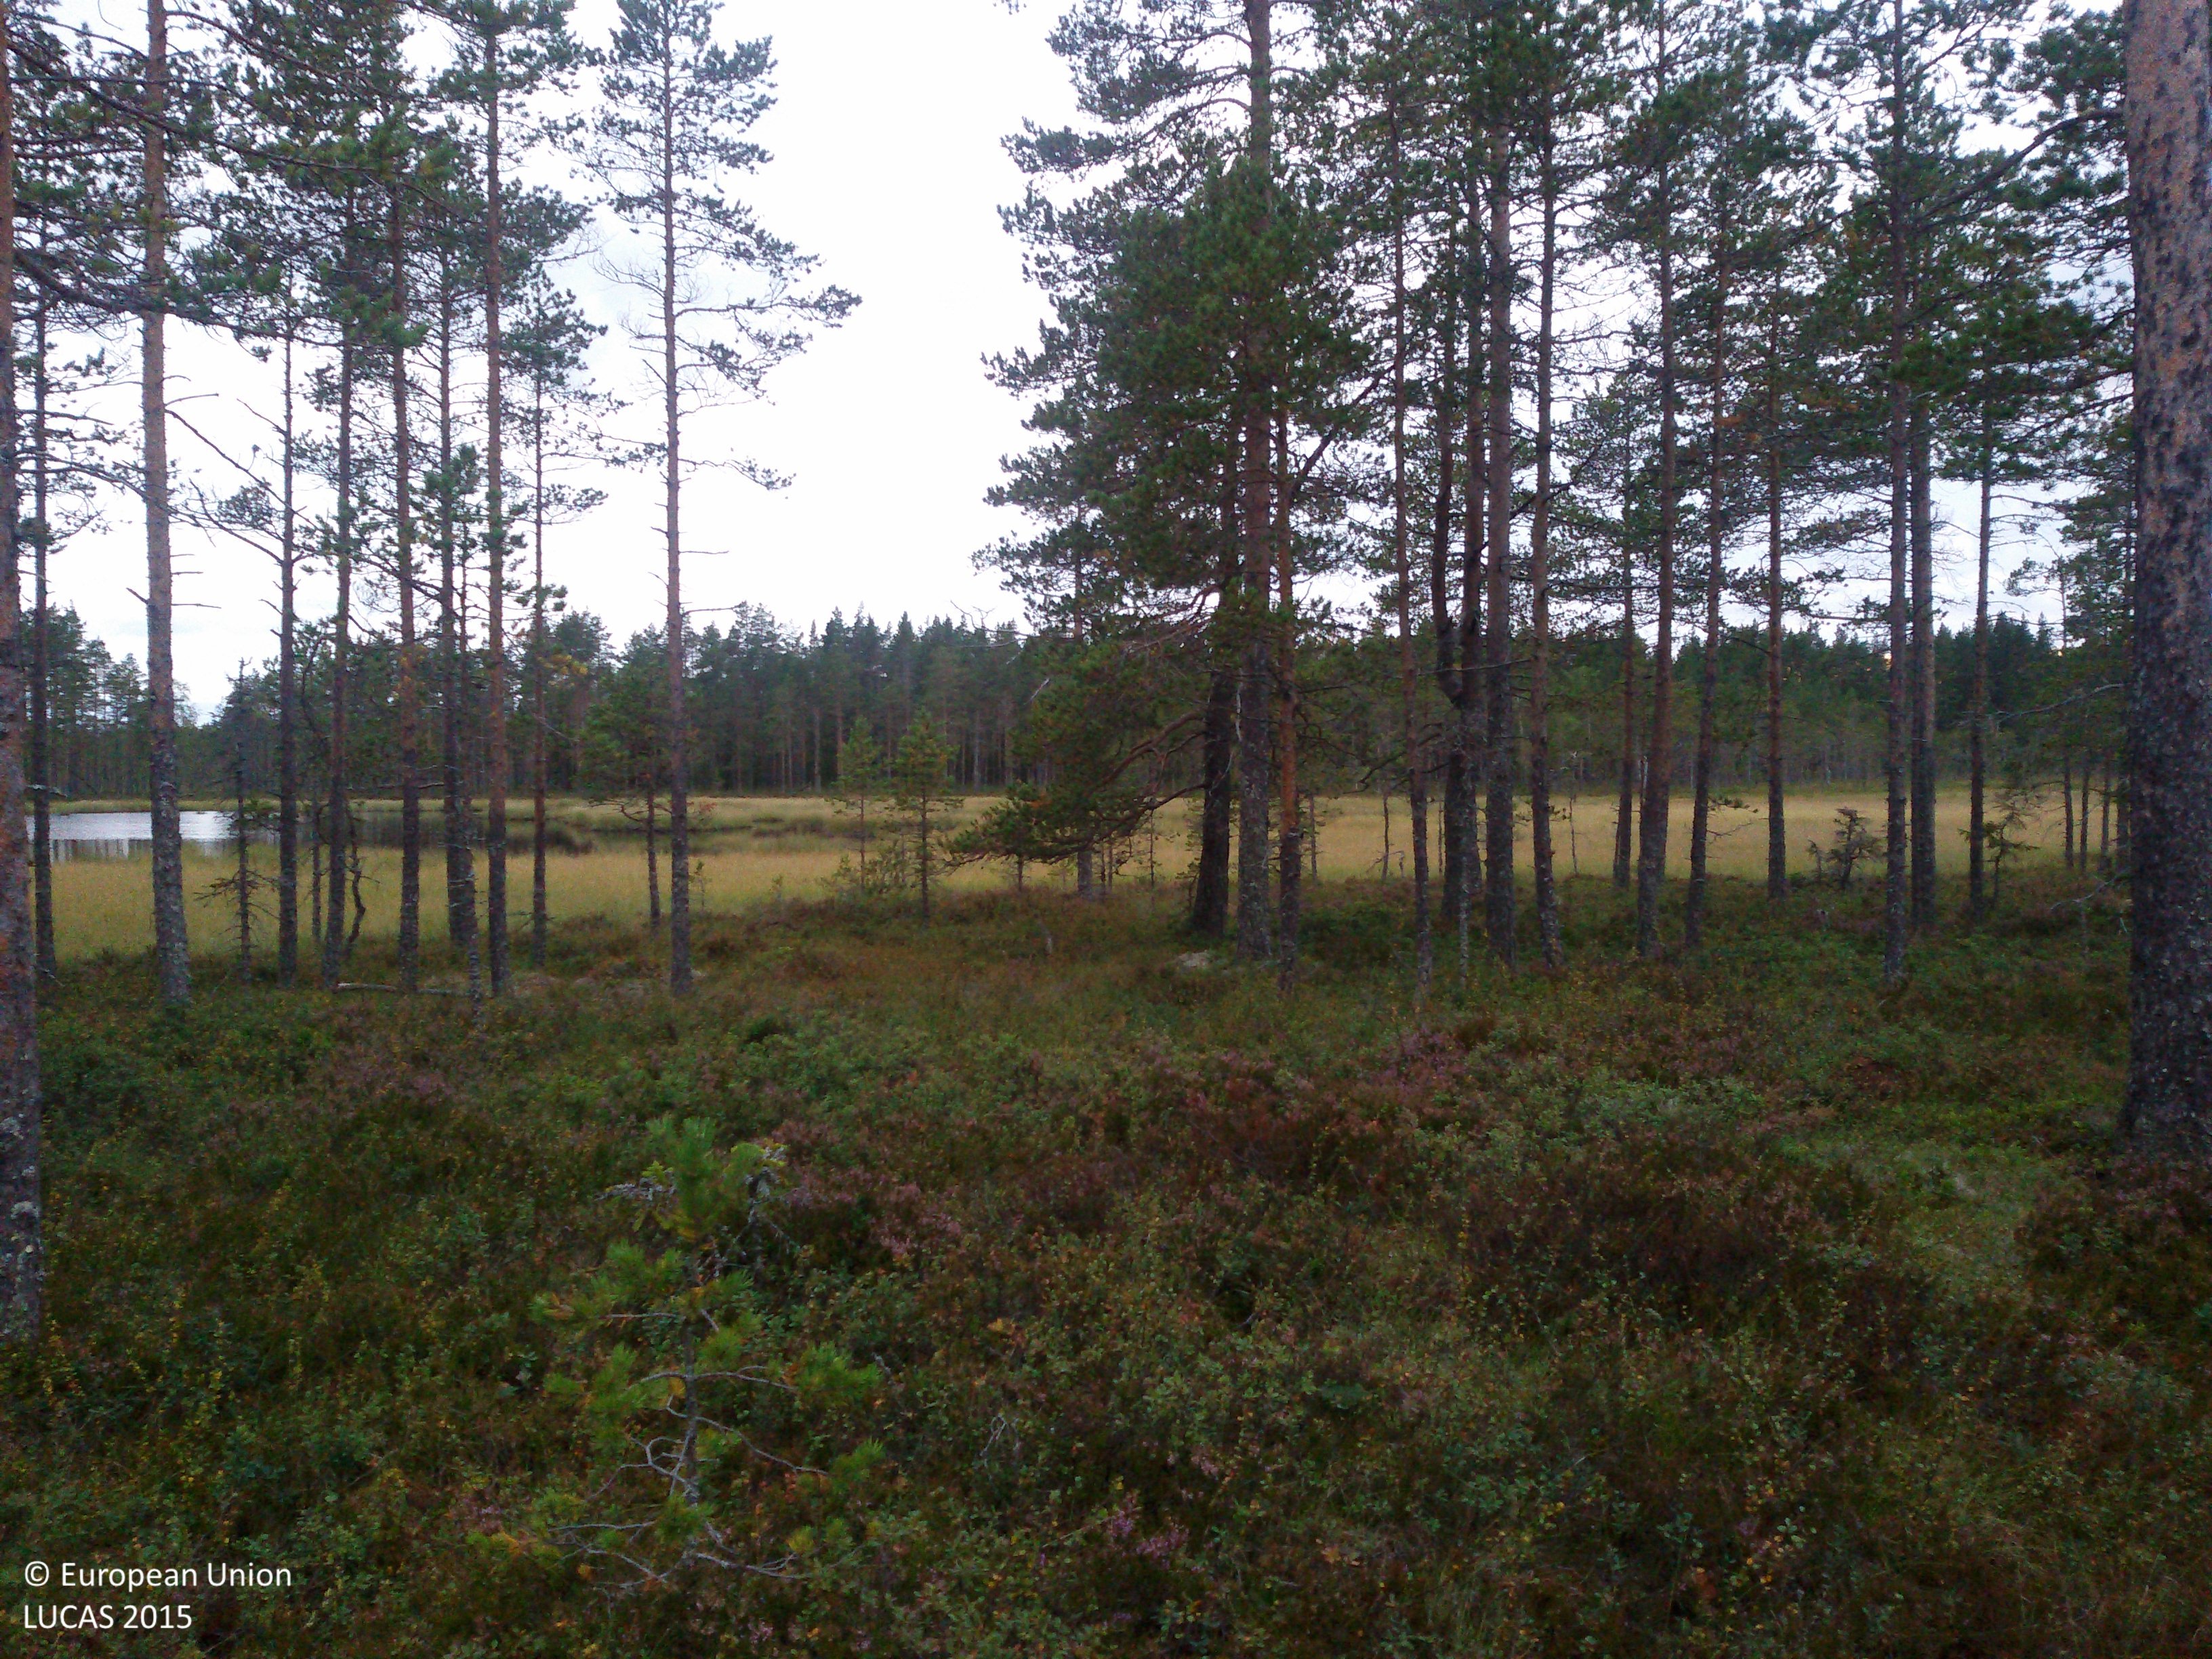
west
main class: Woodland
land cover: Pine dominated coniferous woodland
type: boreal forest
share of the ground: 50 - 75 %
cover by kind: coniferous forest trees 50 %, herbaceous plants 25 %, lichens and mosses 25 %
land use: Forestry
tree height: > 5 m
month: September
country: SE
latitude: 60.8377
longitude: 15.3401
